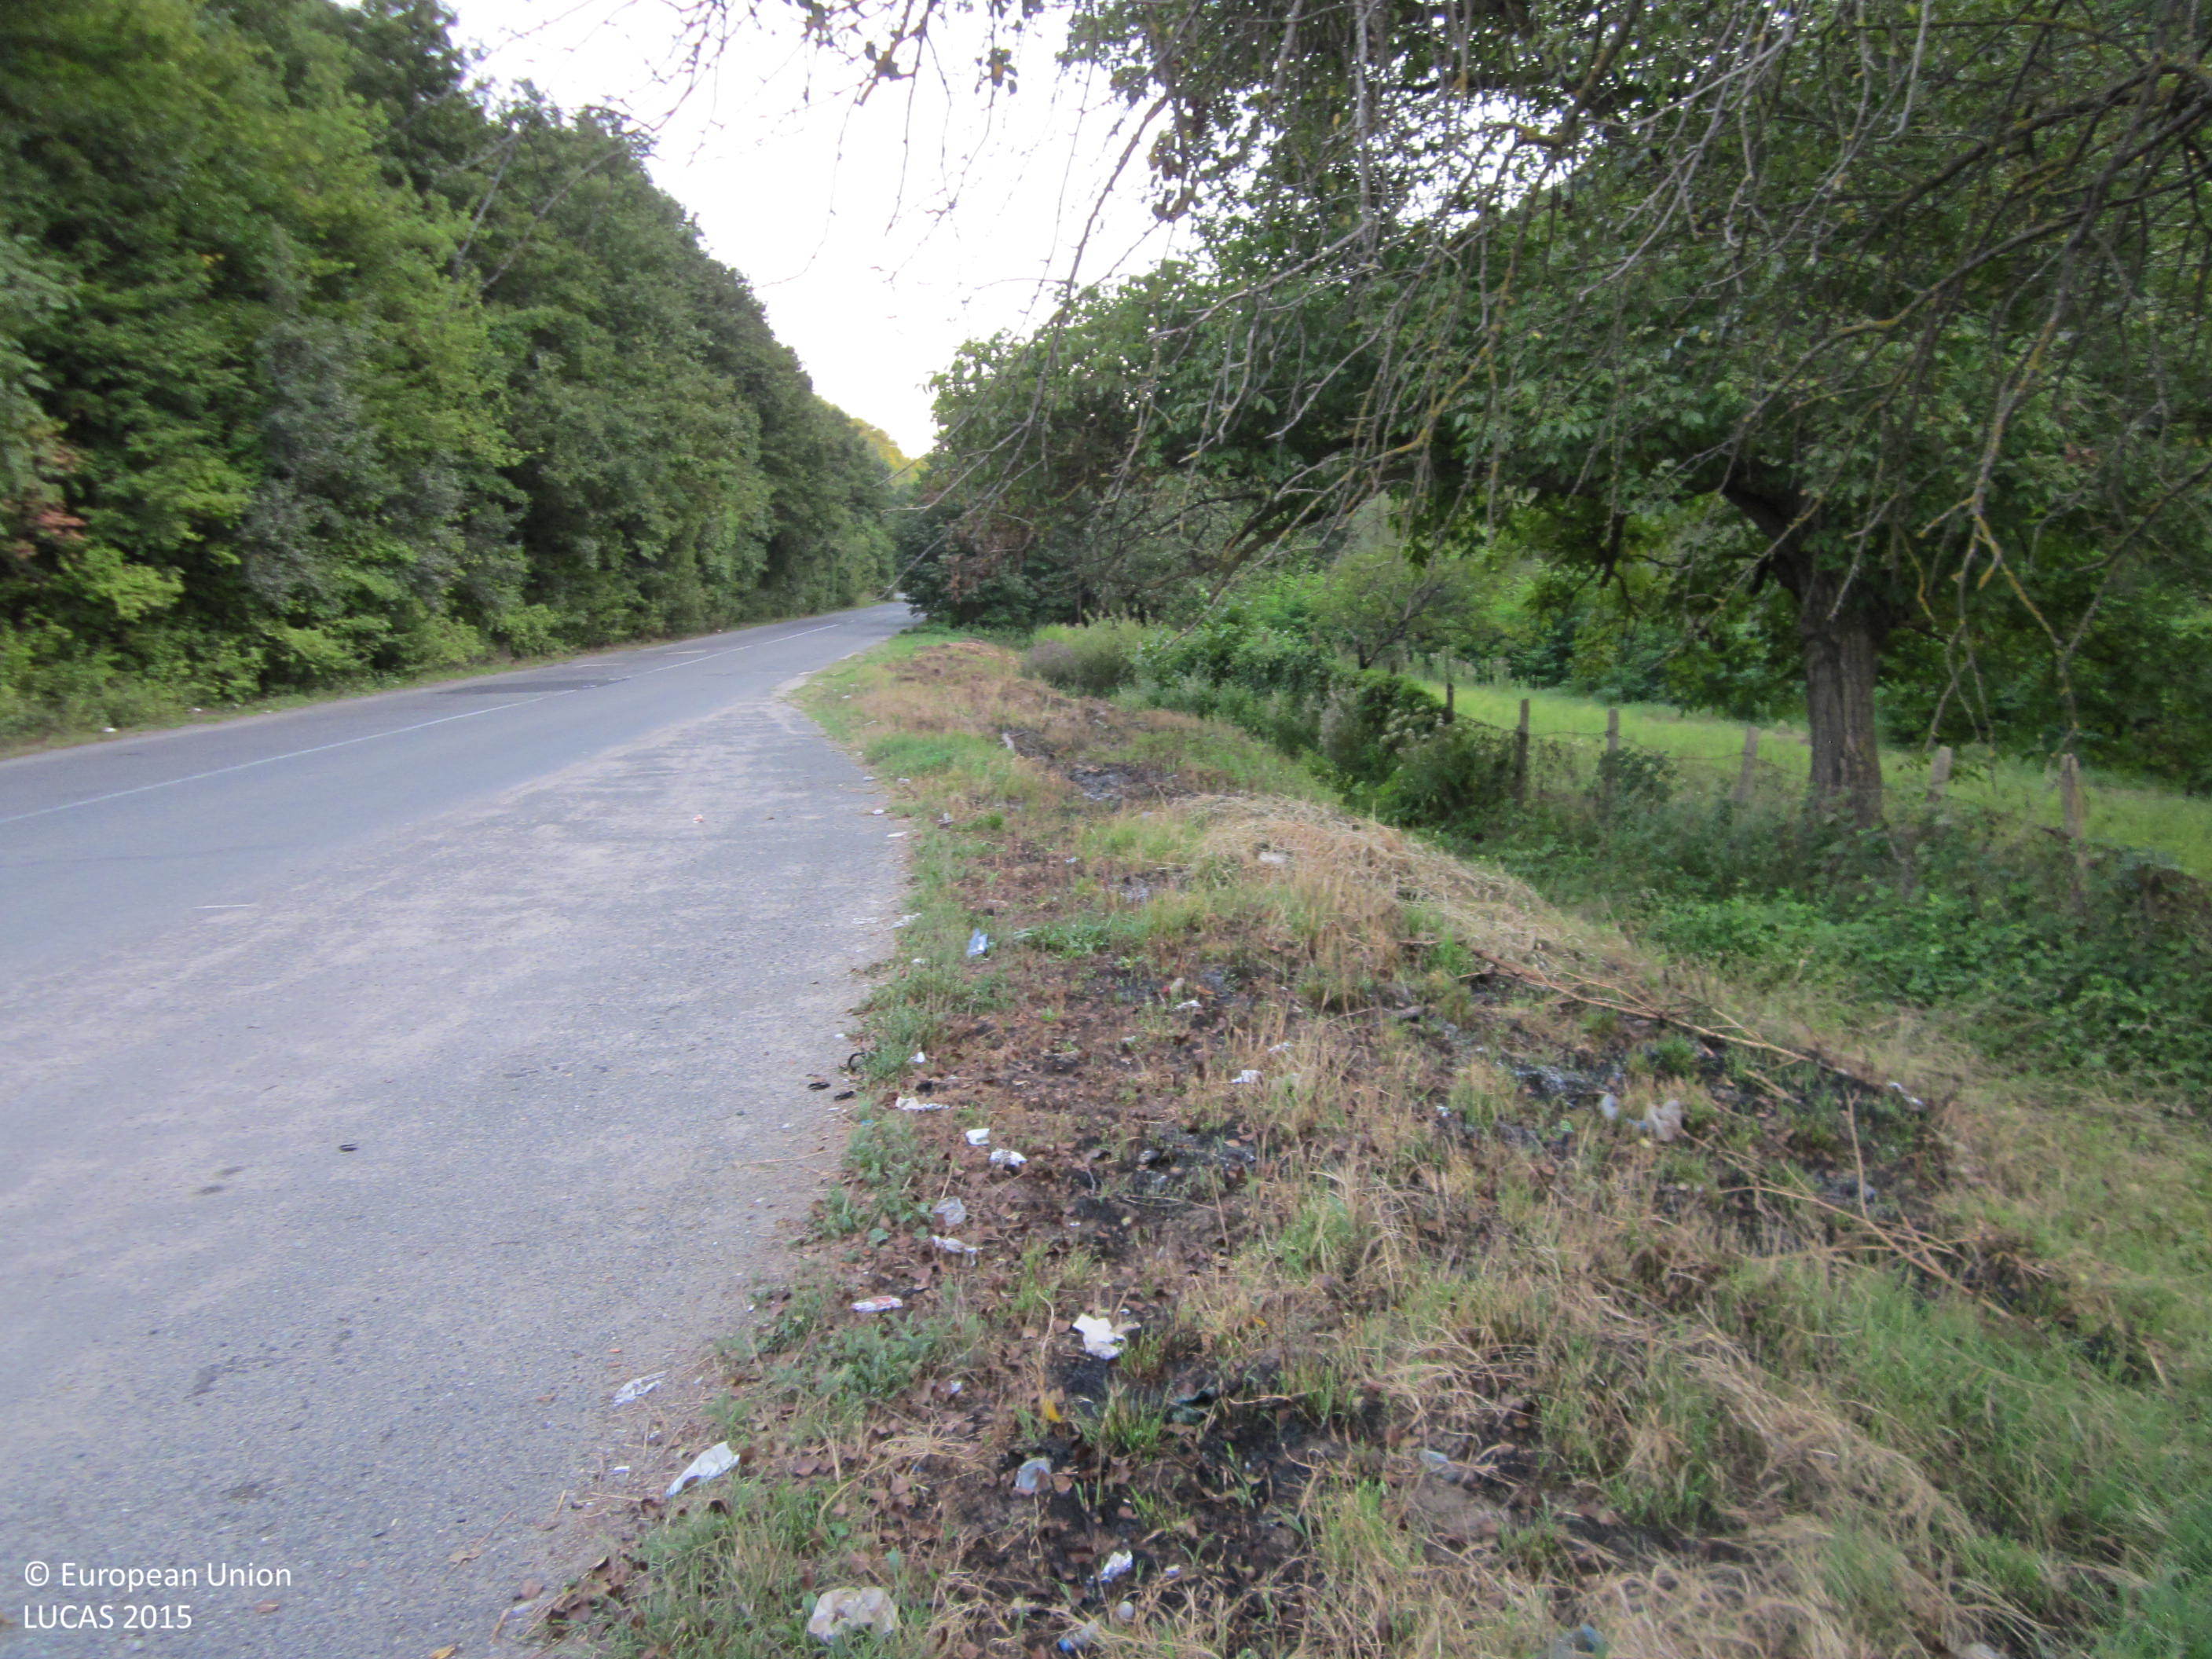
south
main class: Woodland
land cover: Broadleaved woodland
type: mesophytic deciduous forest
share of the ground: > 75 %
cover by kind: broadleaved forest trees 100 %
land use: Forestry
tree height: > 5 m
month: September
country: BG
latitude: 42.8486
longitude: 27.1843
